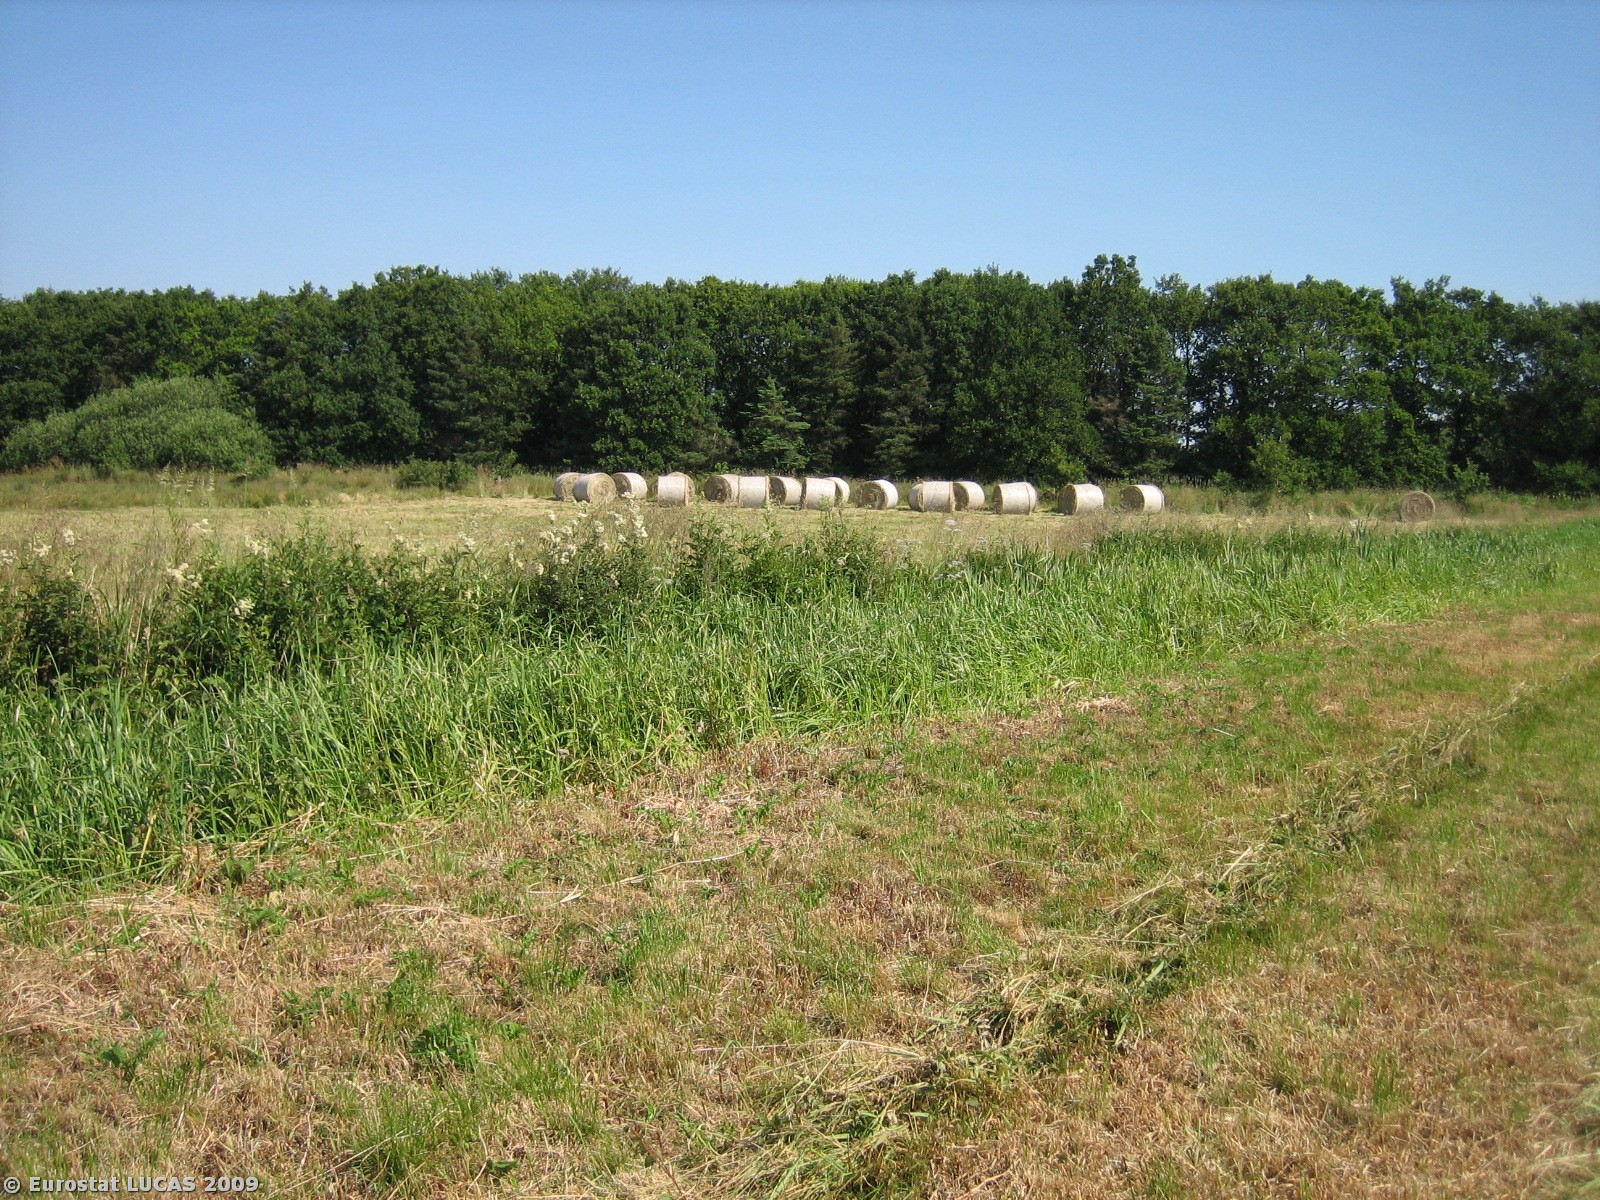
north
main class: Cropland
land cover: Temporary grasslands
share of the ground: > 75 %
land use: Agriculture (excluding fallow land and kitchen gardens)
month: July
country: DK
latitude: 55.4099
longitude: 8.8796
